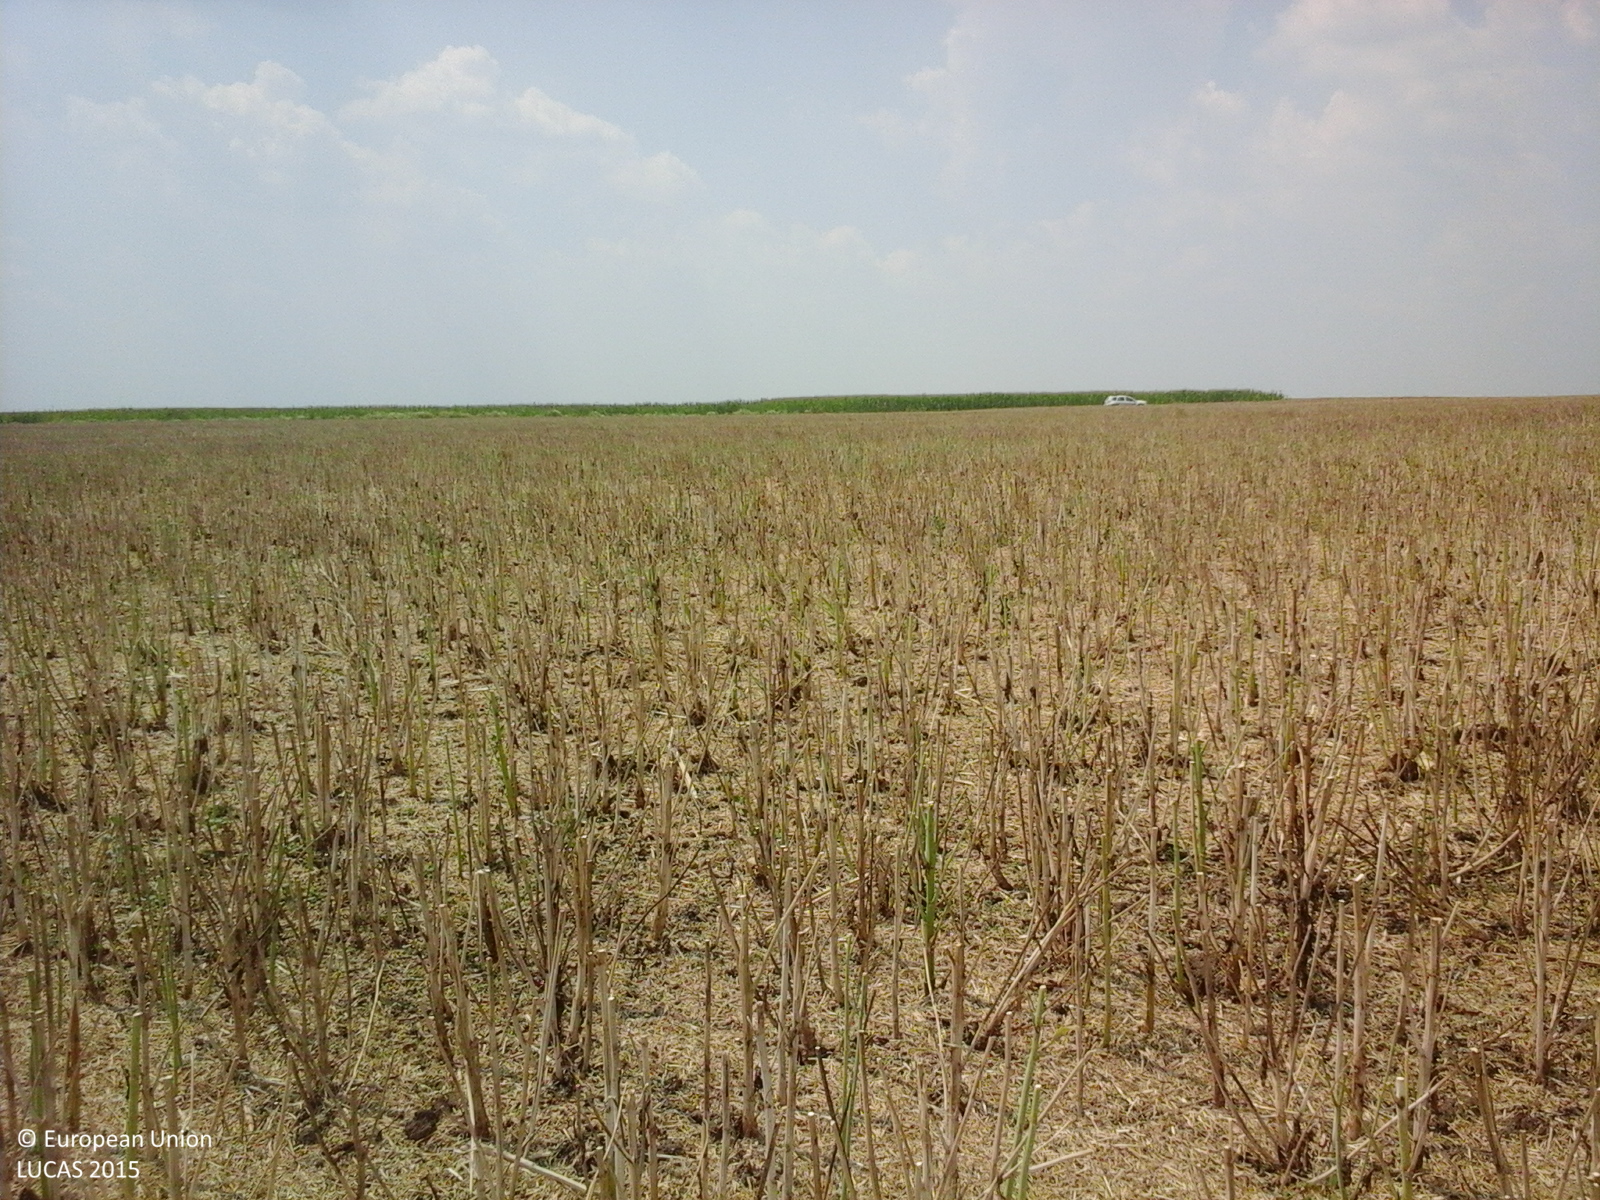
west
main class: Cropland
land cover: Rape and turnip rape
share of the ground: 10 - 25 %
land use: Agriculture (excluding fallow land and kitchen gardens)
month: July
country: RO
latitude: 43.7525
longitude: 25.0906
